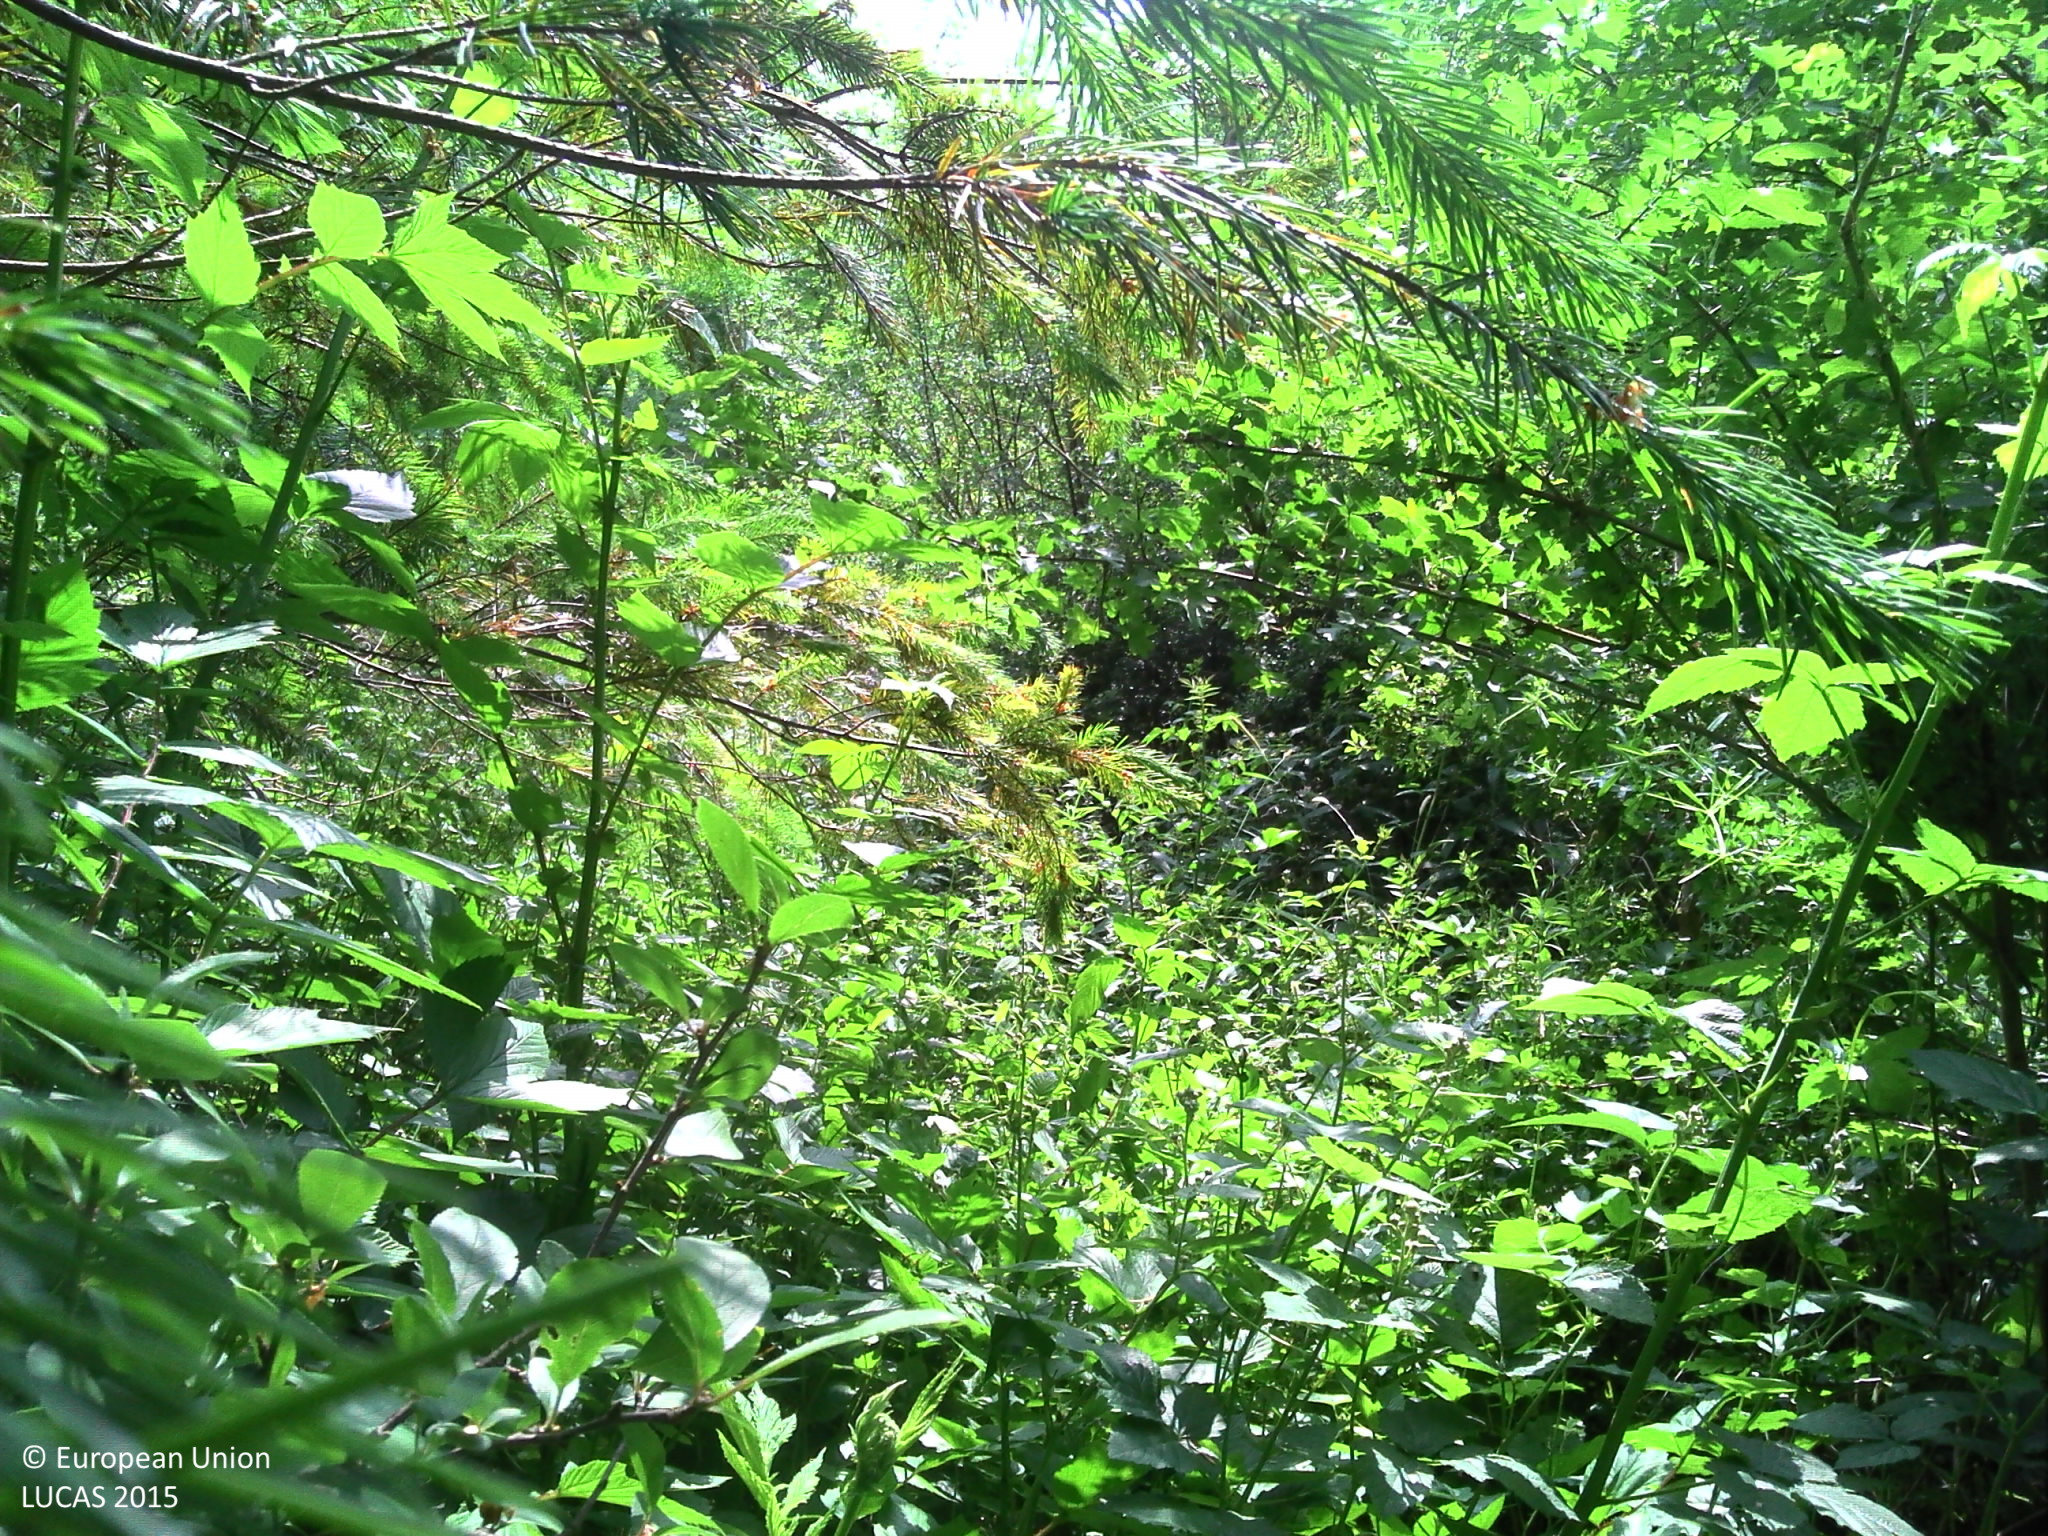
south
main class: Woodland
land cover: Broadleaved woodland
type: mesophytic deciduous forest
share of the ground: 50 - 75 %
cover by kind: broadleaved forest trees 65 %, shrubs 20 %, herbaceous plants 10 %, coniferous forest trees 5 %
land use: Forestry
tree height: > 5 m
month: June
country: BE
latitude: 50.3482
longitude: 5.5153
